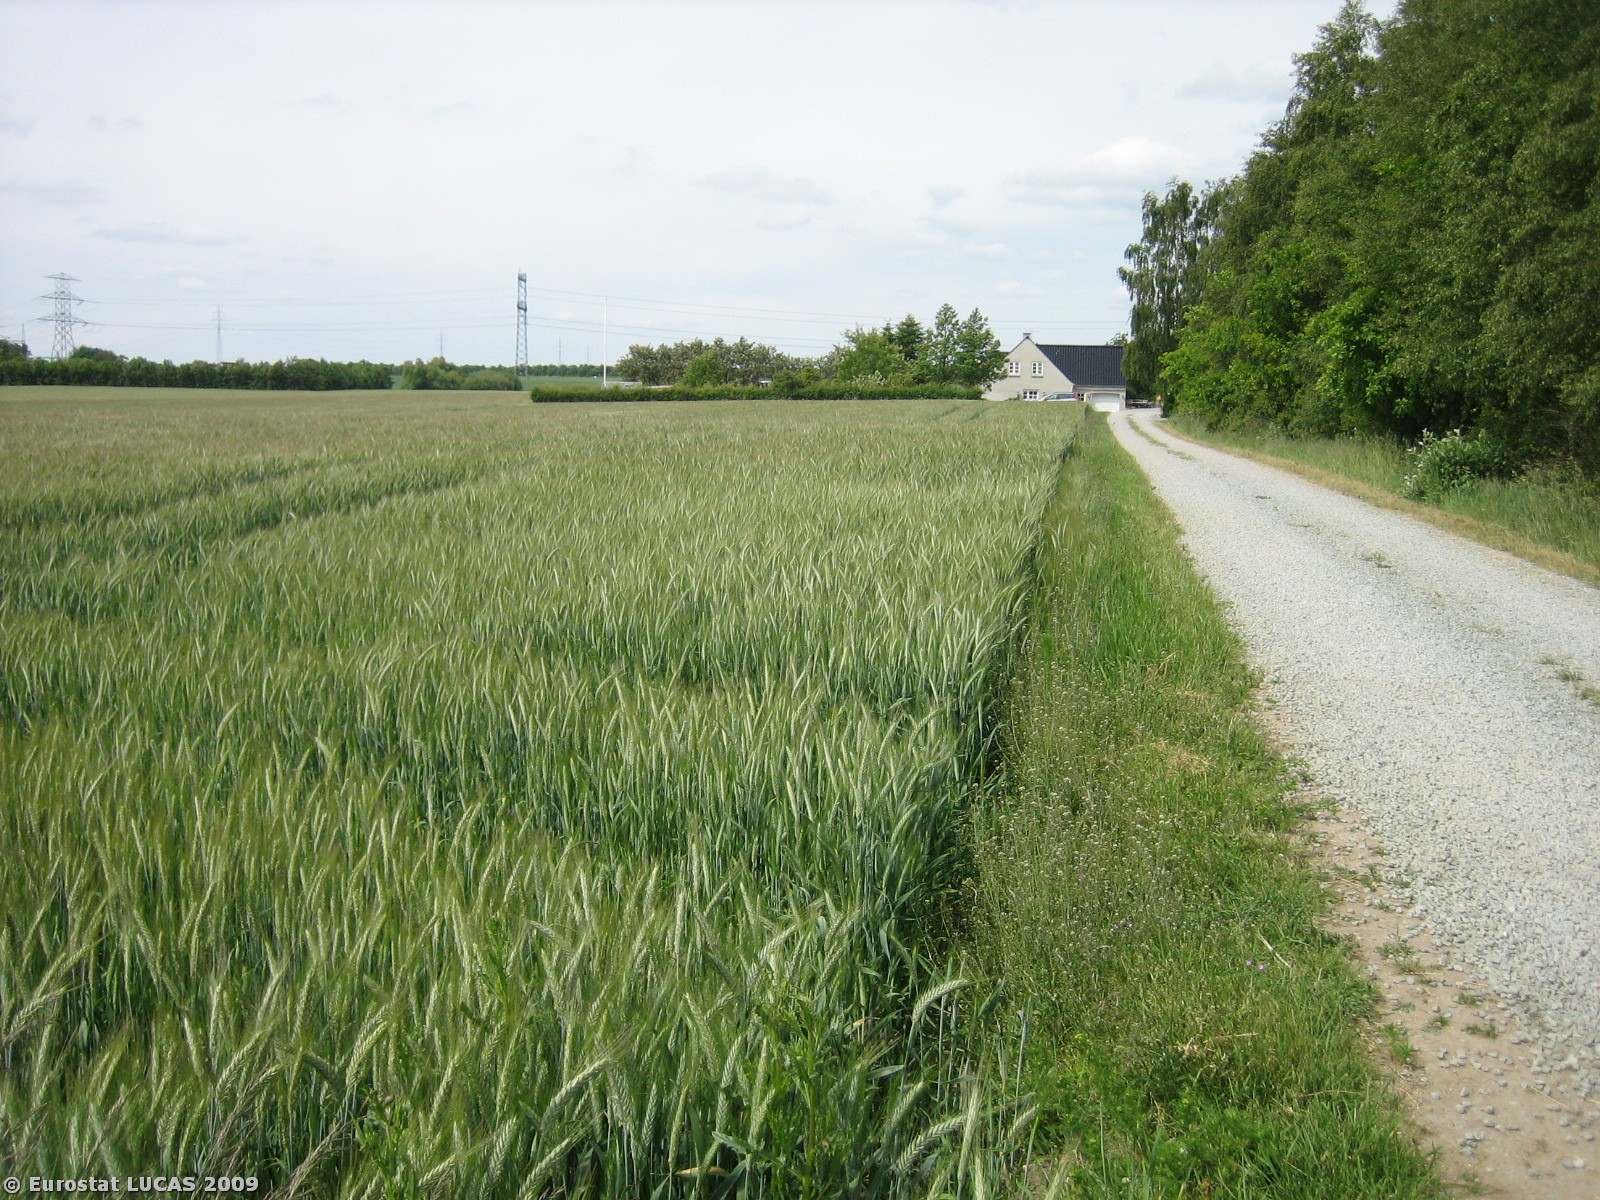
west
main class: Cropland
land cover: Rye
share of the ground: > 75 %
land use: Agriculture (excluding fallow land and kitchen gardens)
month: June
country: DK
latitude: 56.2775
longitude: 10.1452
